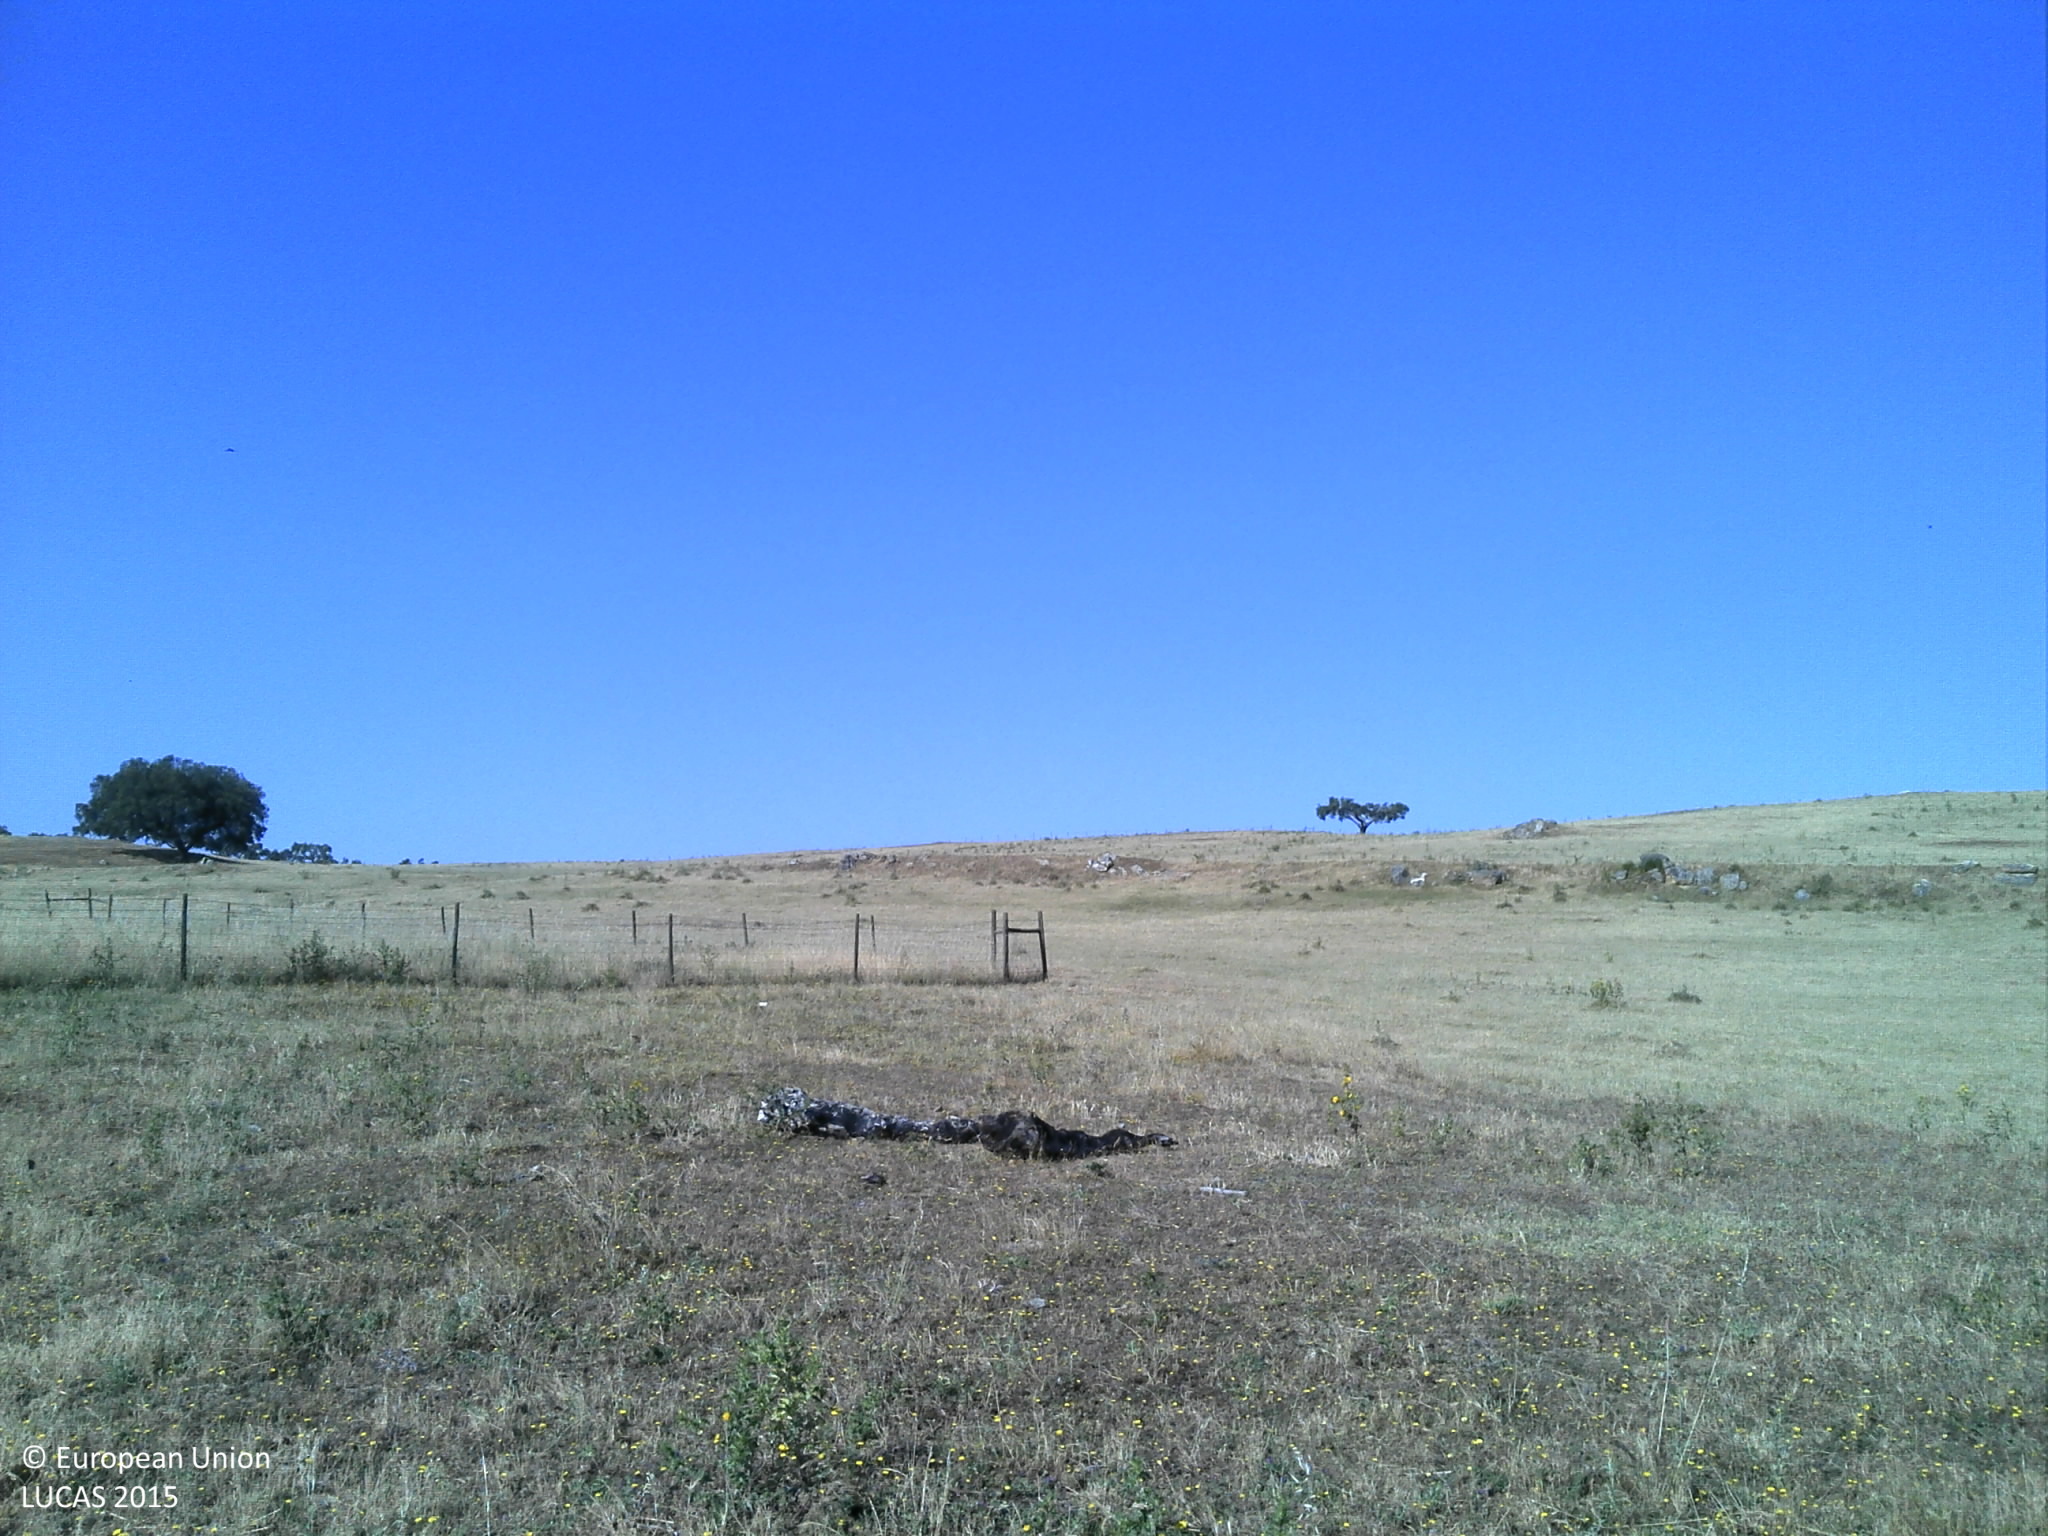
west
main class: Grassland
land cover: Grassland without tree/shrub cover
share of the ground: 25 - 50 %
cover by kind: herbaceous plants 45 %, unconsolidated bare surface 45 %
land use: Agriculture (excluding fallow land and kitchen gardens)
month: June
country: PT
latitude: 38.6514
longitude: -8.0501
